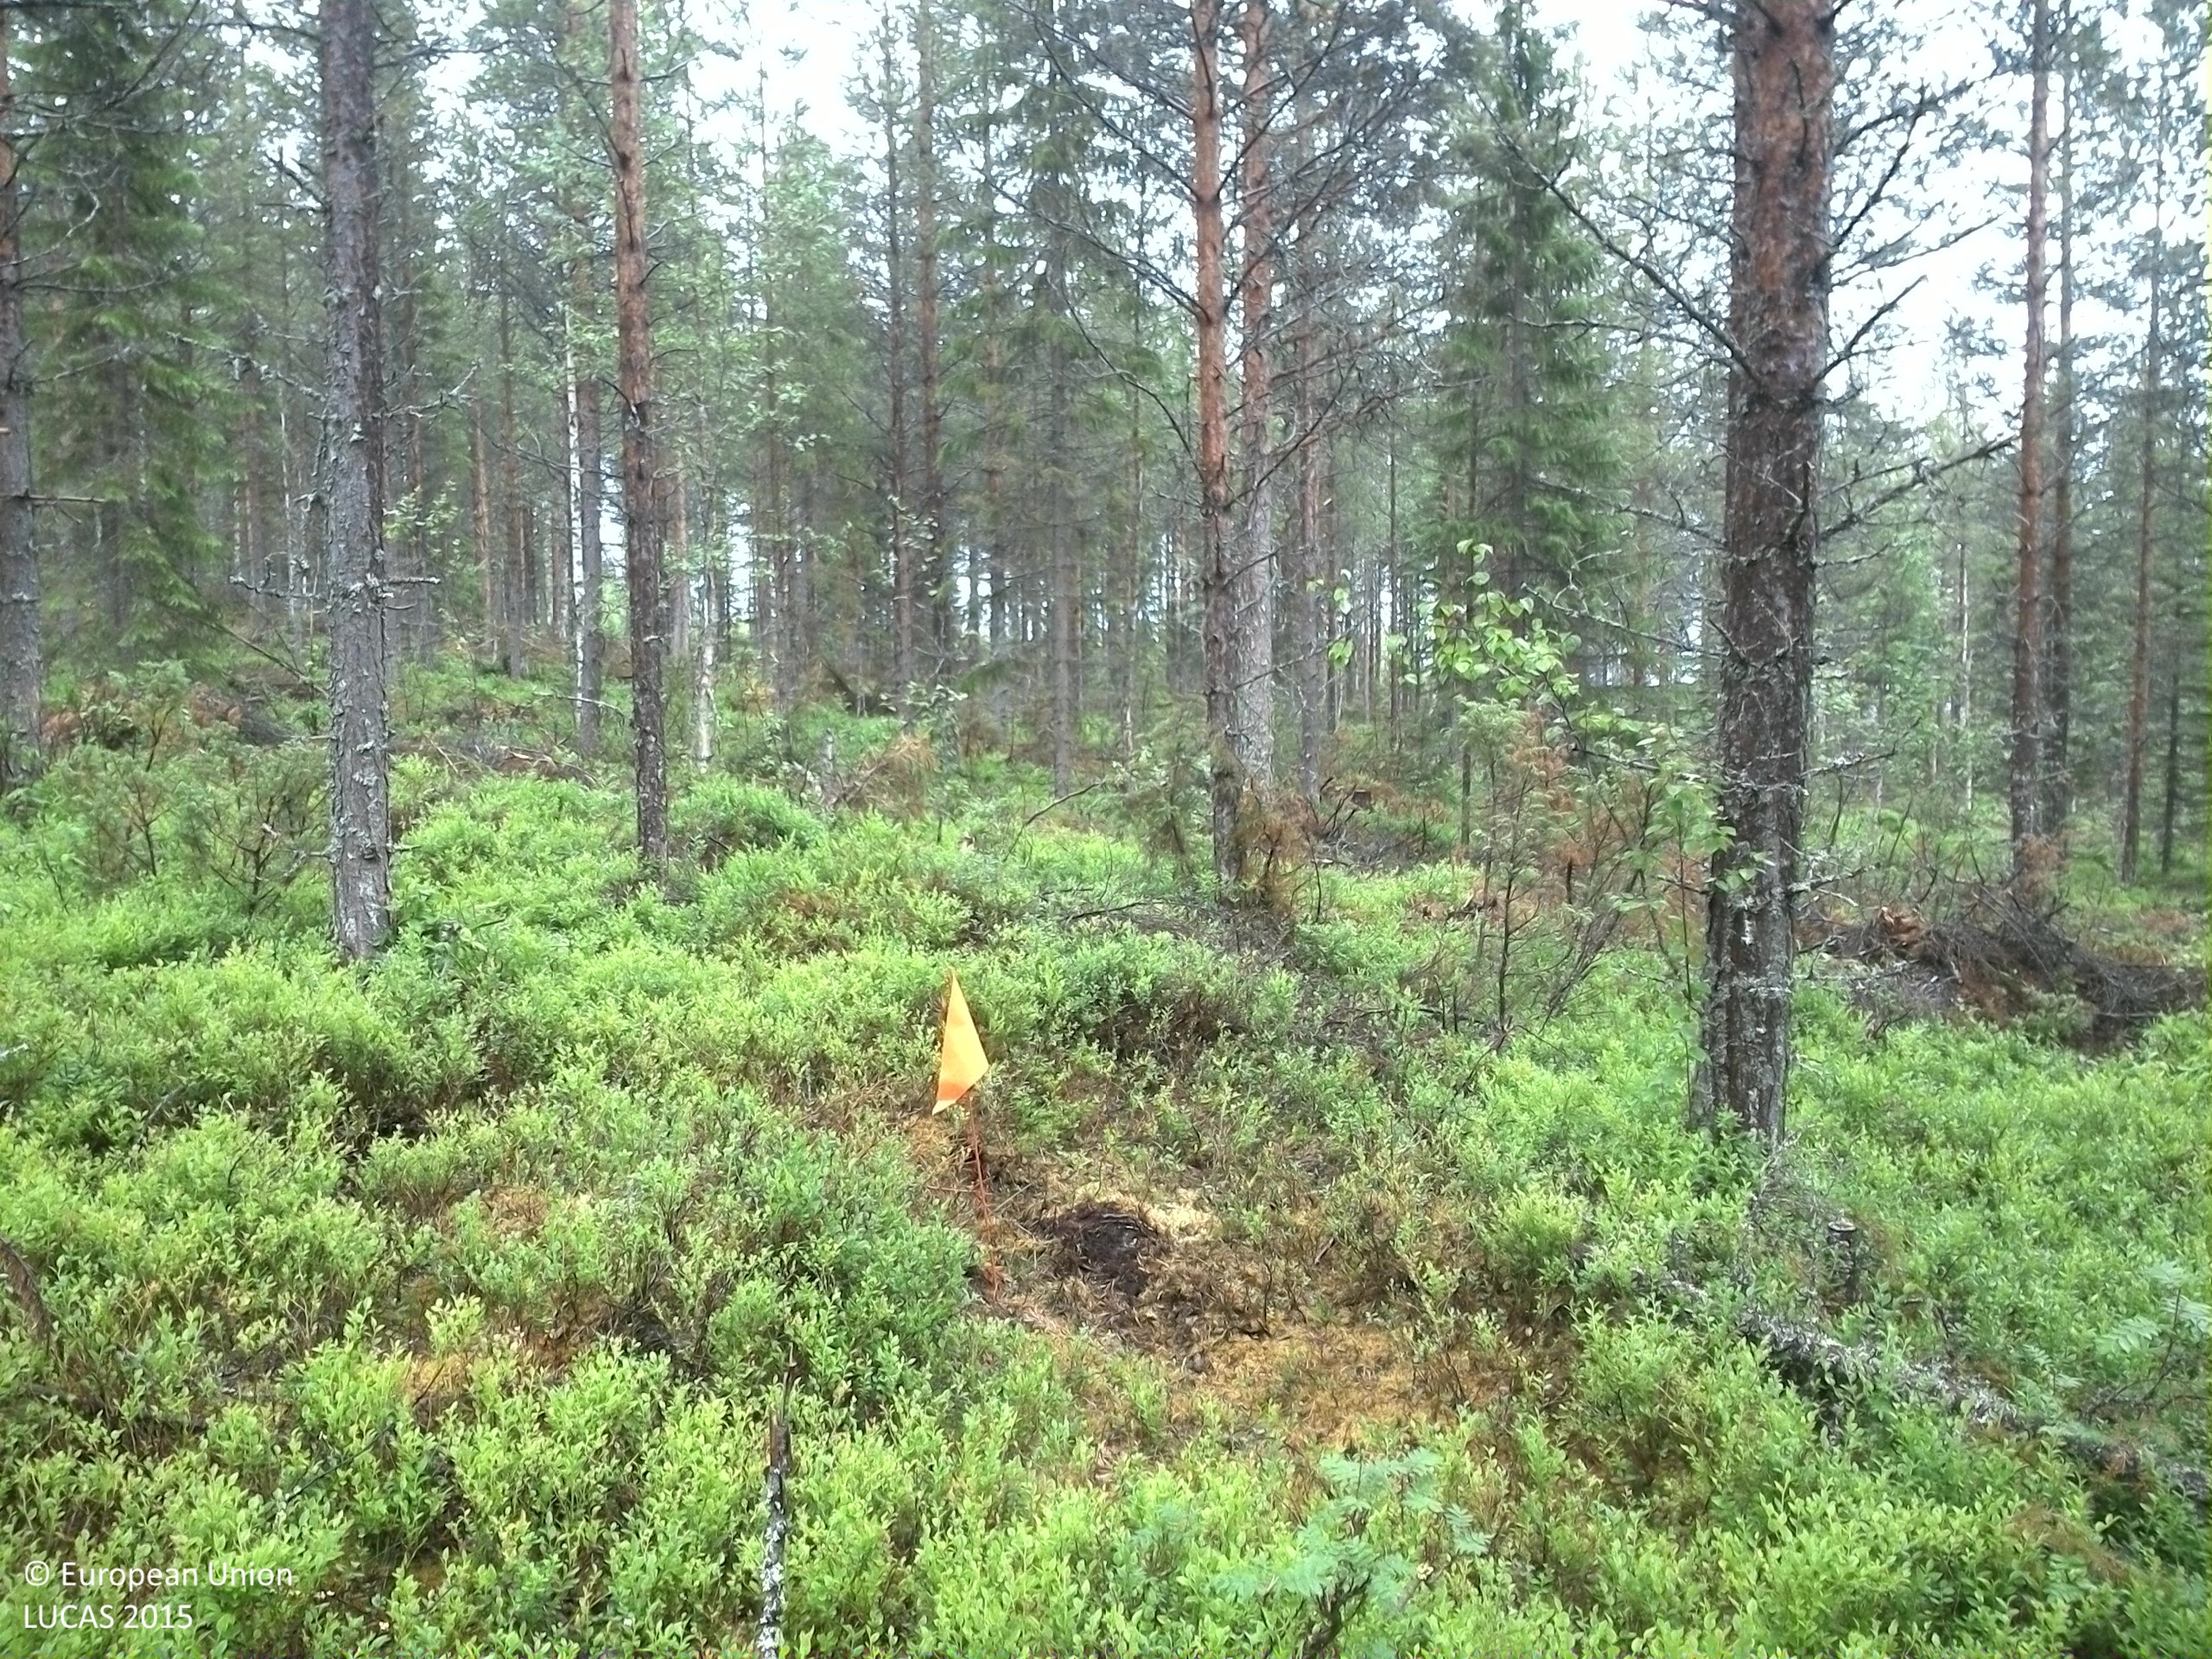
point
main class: Woodland
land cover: Pine dominated mixed woodland
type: boreal forest
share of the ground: 50 - 75 %
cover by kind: coniferous forest trees 45 %, shrubs 20 %, broadleaved forest trees 15 %, herbaceous plants 10 %, lichens and mosses 10 %
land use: Forestry
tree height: > 5 m
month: July
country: SE
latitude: 63.6693
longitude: 17.2676
